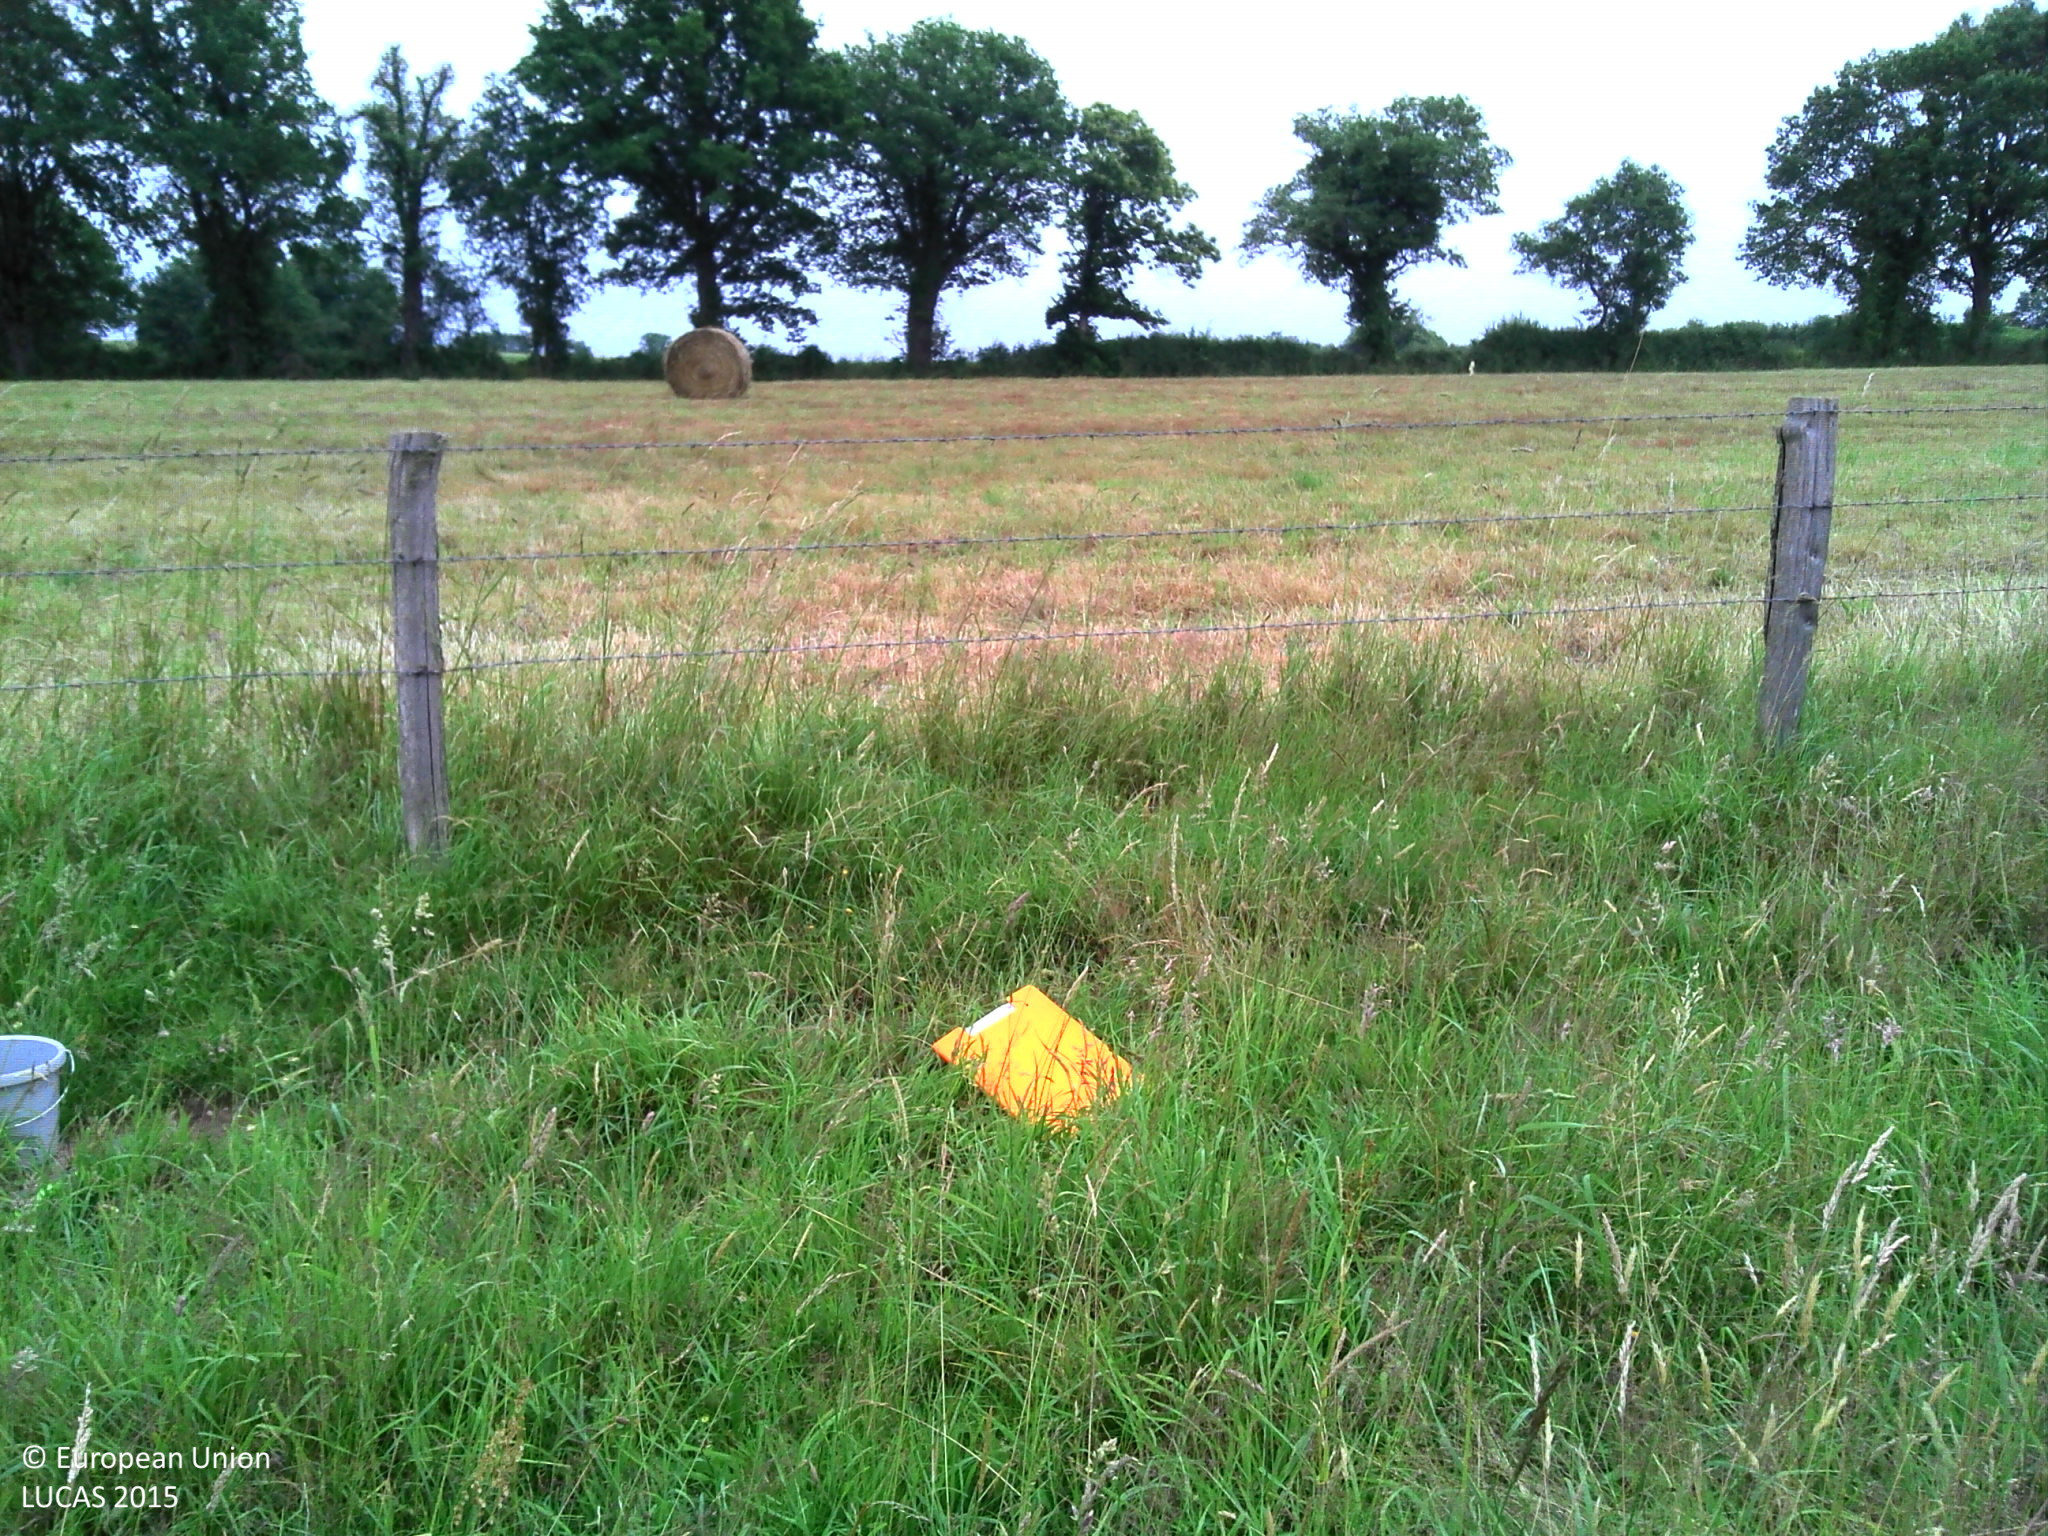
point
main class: Grassland
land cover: Grassland without tree/shrub cover
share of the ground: > 75 %
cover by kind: herbaceous plants 100 %
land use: Agriculture (excluding fallow land and kitchen gardens)
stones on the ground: < 10 %
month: June
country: FR
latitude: 46.6112
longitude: 2.7492
